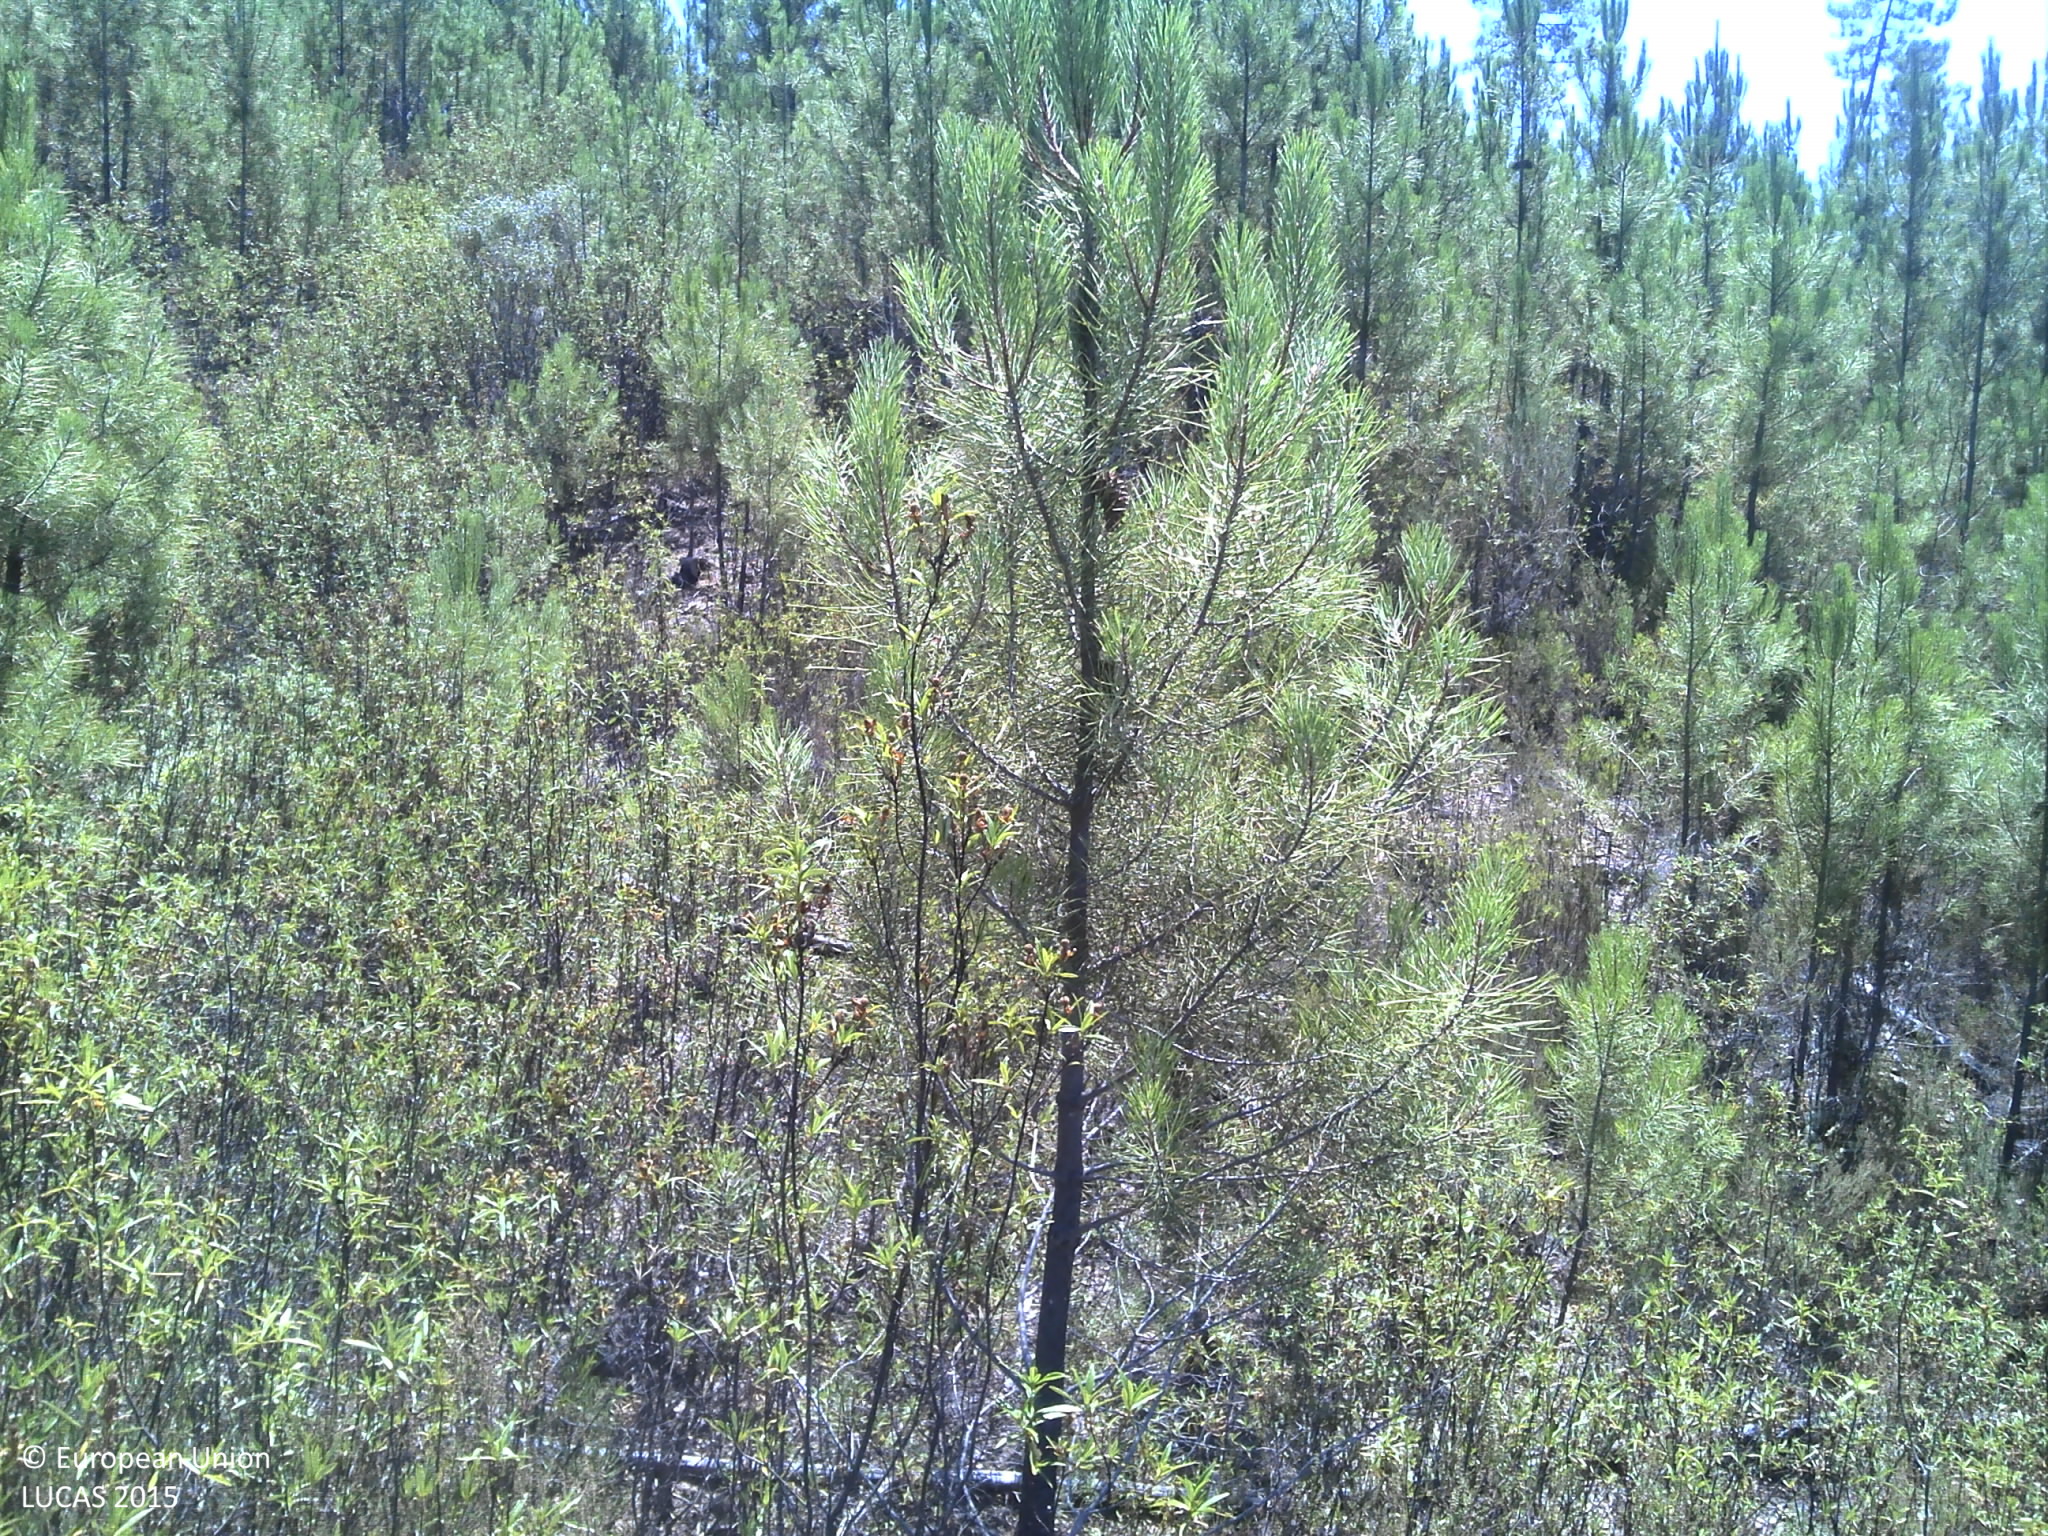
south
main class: Woodland
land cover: Pine dominated coniferous woodland
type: coniferous forest of the mediterranean region
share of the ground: 10 - 25 %
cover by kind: shrubs 75 %, coniferous forest trees 15 %, unconsolidated bare surface 10 %
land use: Forestry
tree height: < 5 m
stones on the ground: 10 - 25 %
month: July
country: PT
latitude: 39.9413
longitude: -7.6722
